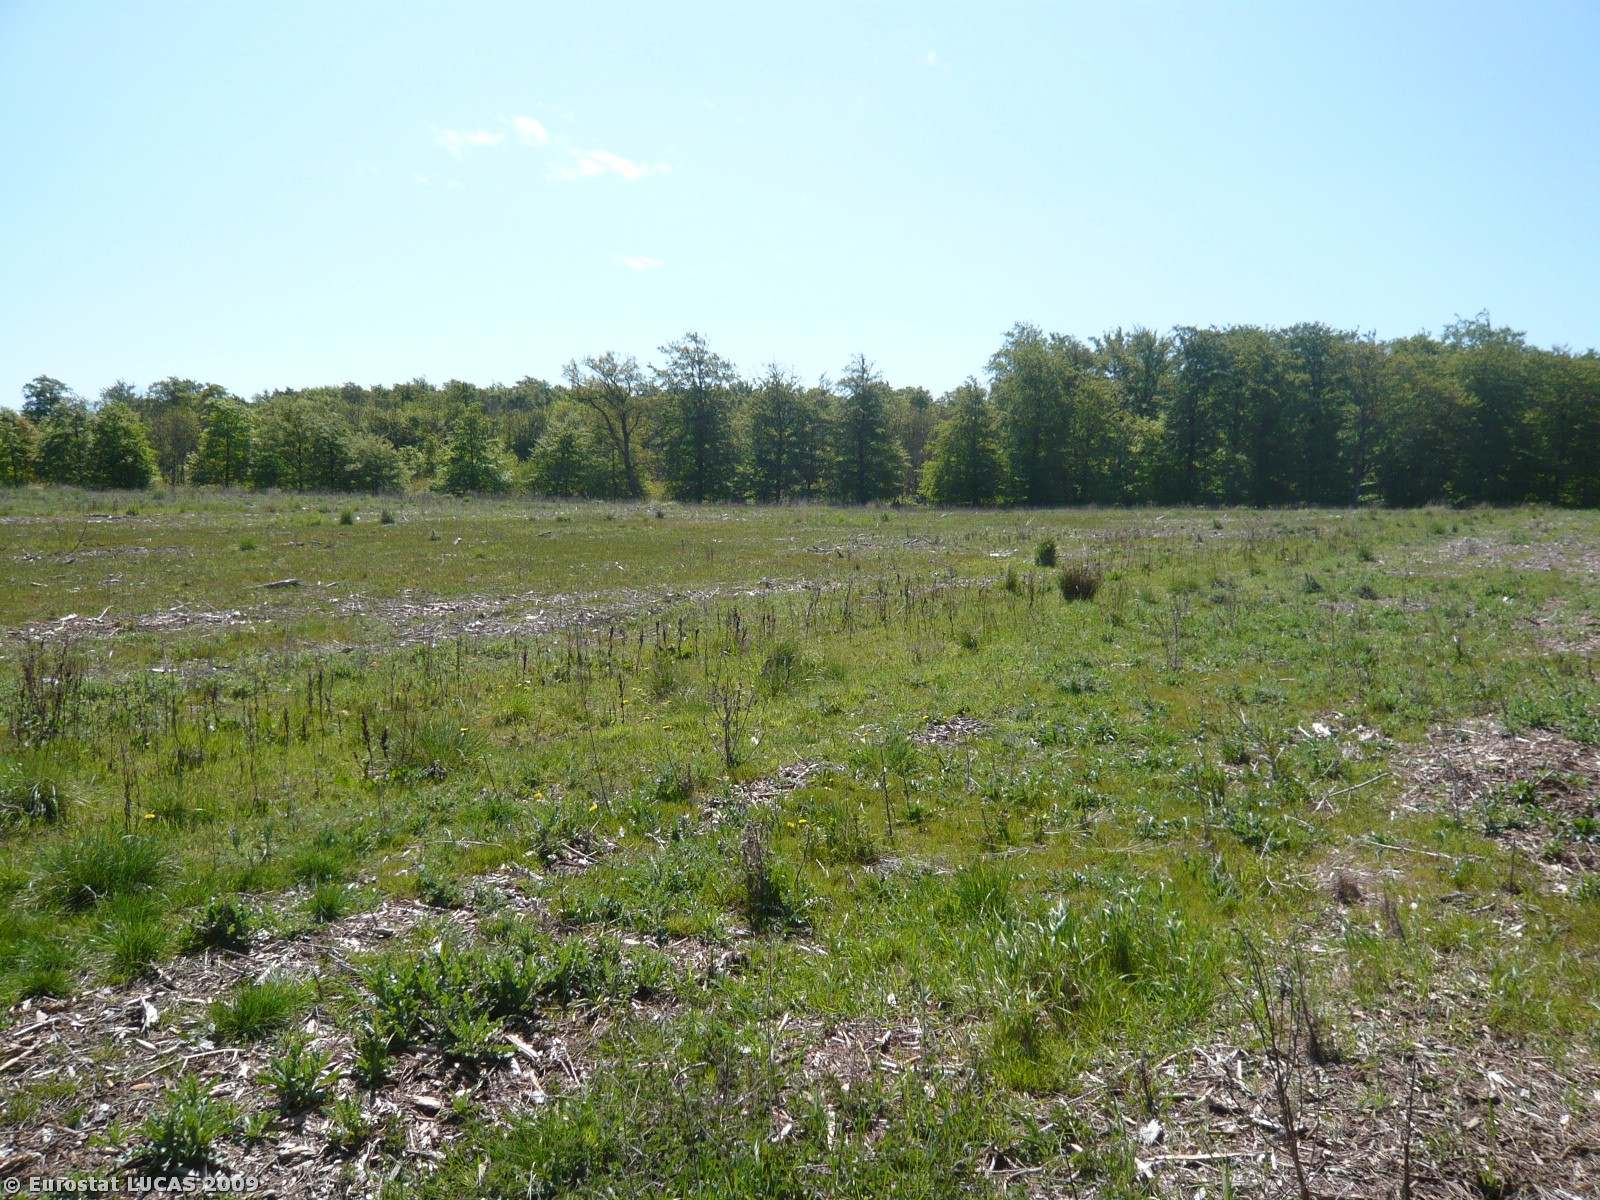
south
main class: Grassland
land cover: Spontaneously vegetated surfaces
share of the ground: 10 - 25 %
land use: Forestry
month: May
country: DK
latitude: 55.0756
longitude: 11.9878
